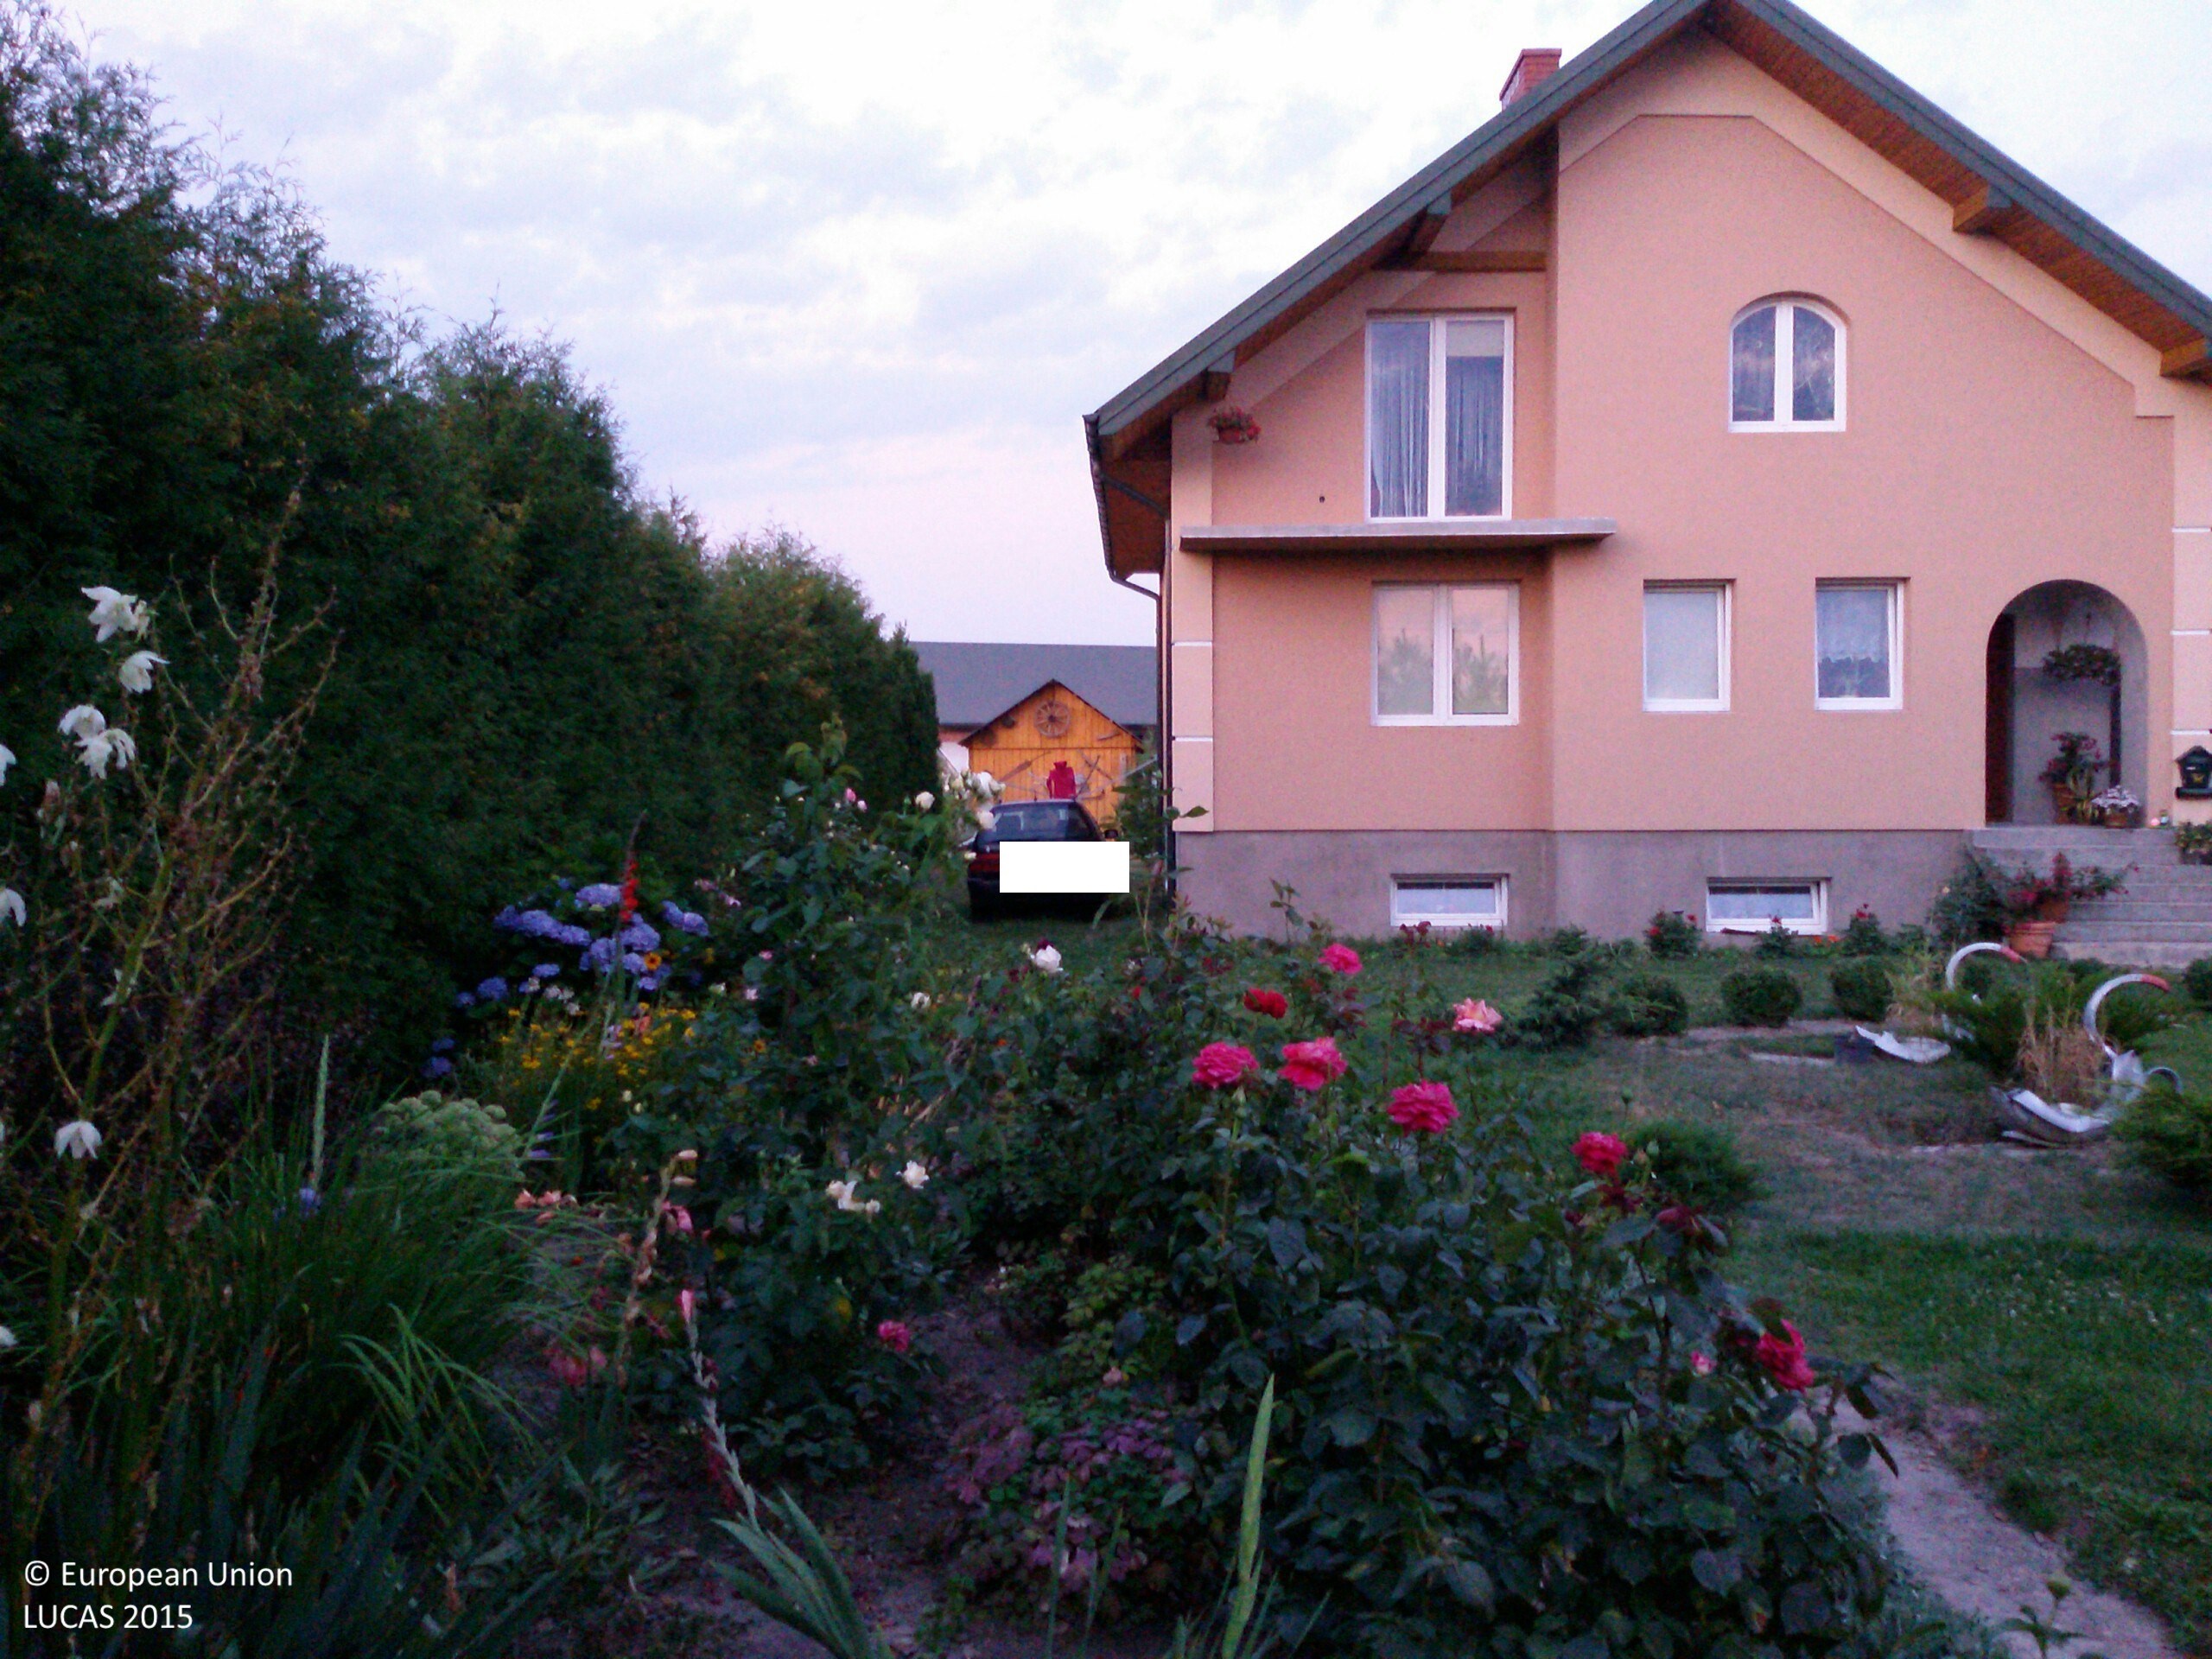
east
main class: Woodland
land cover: Broadleaved woodland
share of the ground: 10 - 25 %
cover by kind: shrubs 65 %, herbaceous plants 25 %, broadleaved forest trees 10 %
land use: Residential
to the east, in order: Broadleaved woodland; Artificial constructions in urban areas; Grassland without tree/shrub cover; Common wheat; Barley
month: August
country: PL
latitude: 51.4455
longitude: 22.9518
